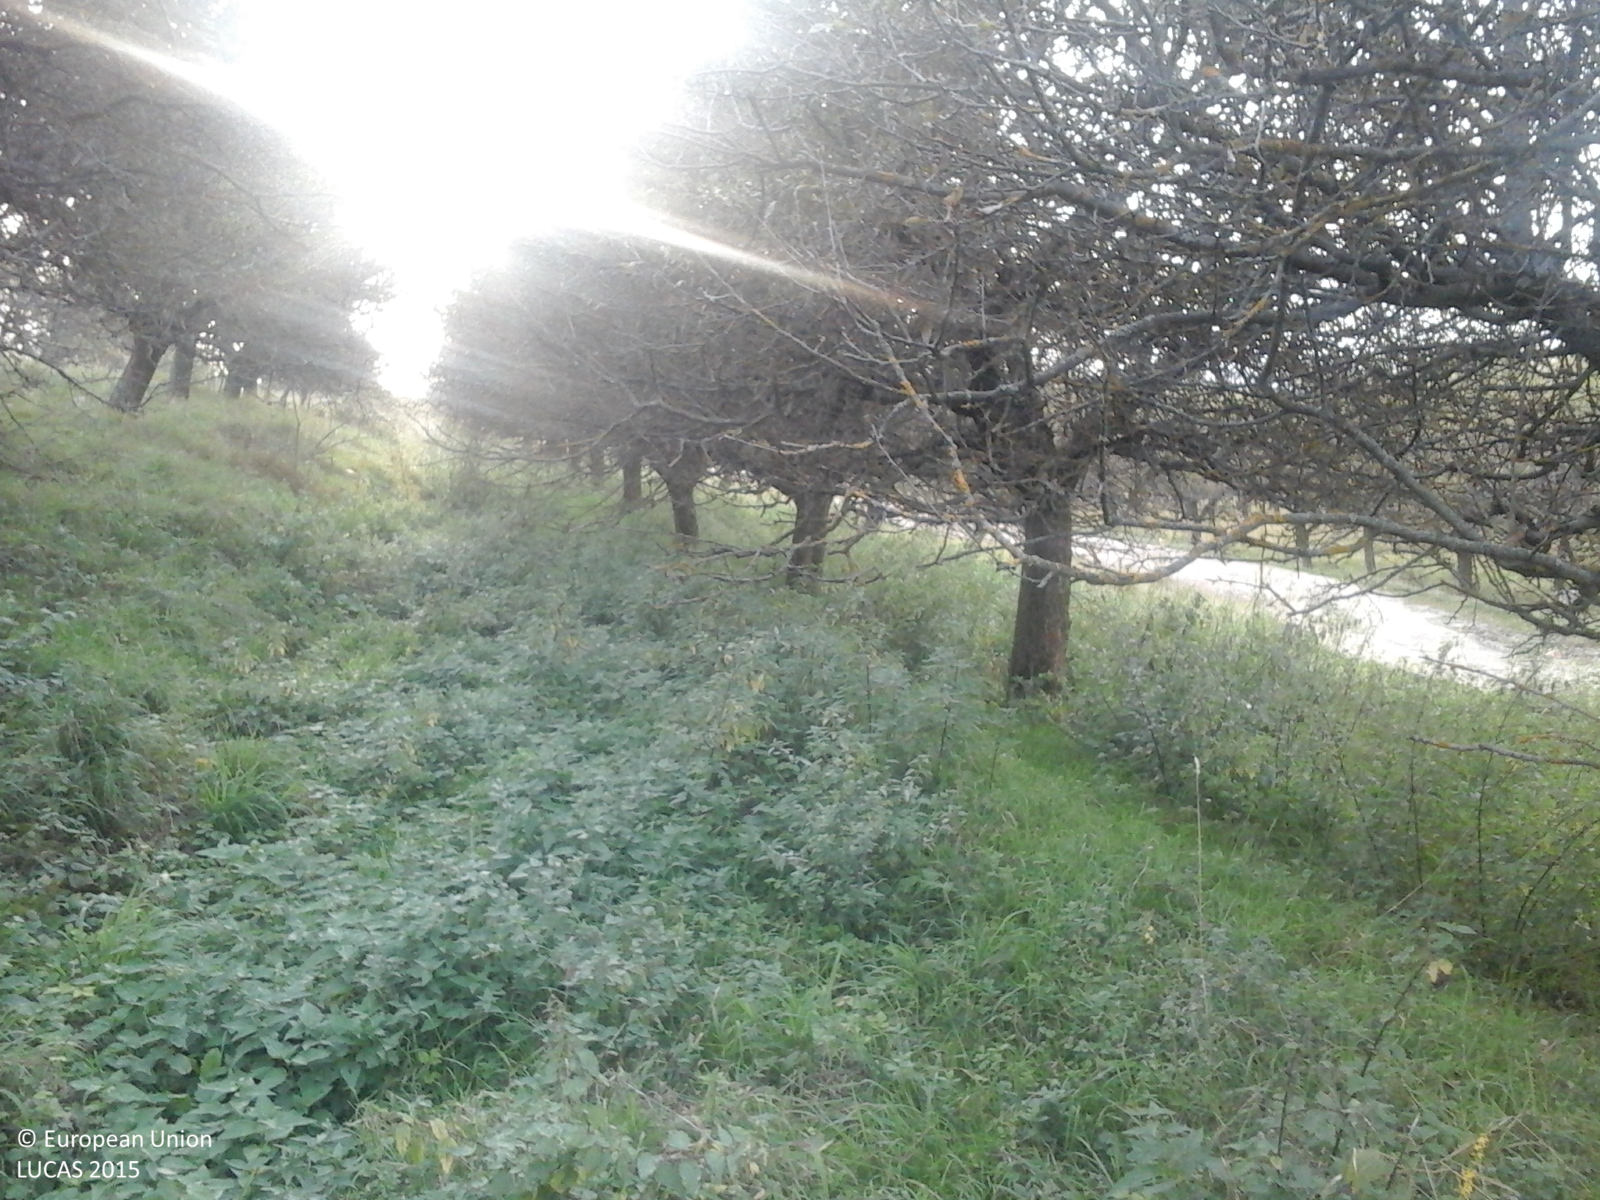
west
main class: Cropland
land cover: Apple fruit
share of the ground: > 75 %
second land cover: Grassland without tree/shrub cover
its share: > 75 %
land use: Agriculture (excluding fallow land and kitchen gardens)
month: September
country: RO
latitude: 46.7351
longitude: 23.6160
